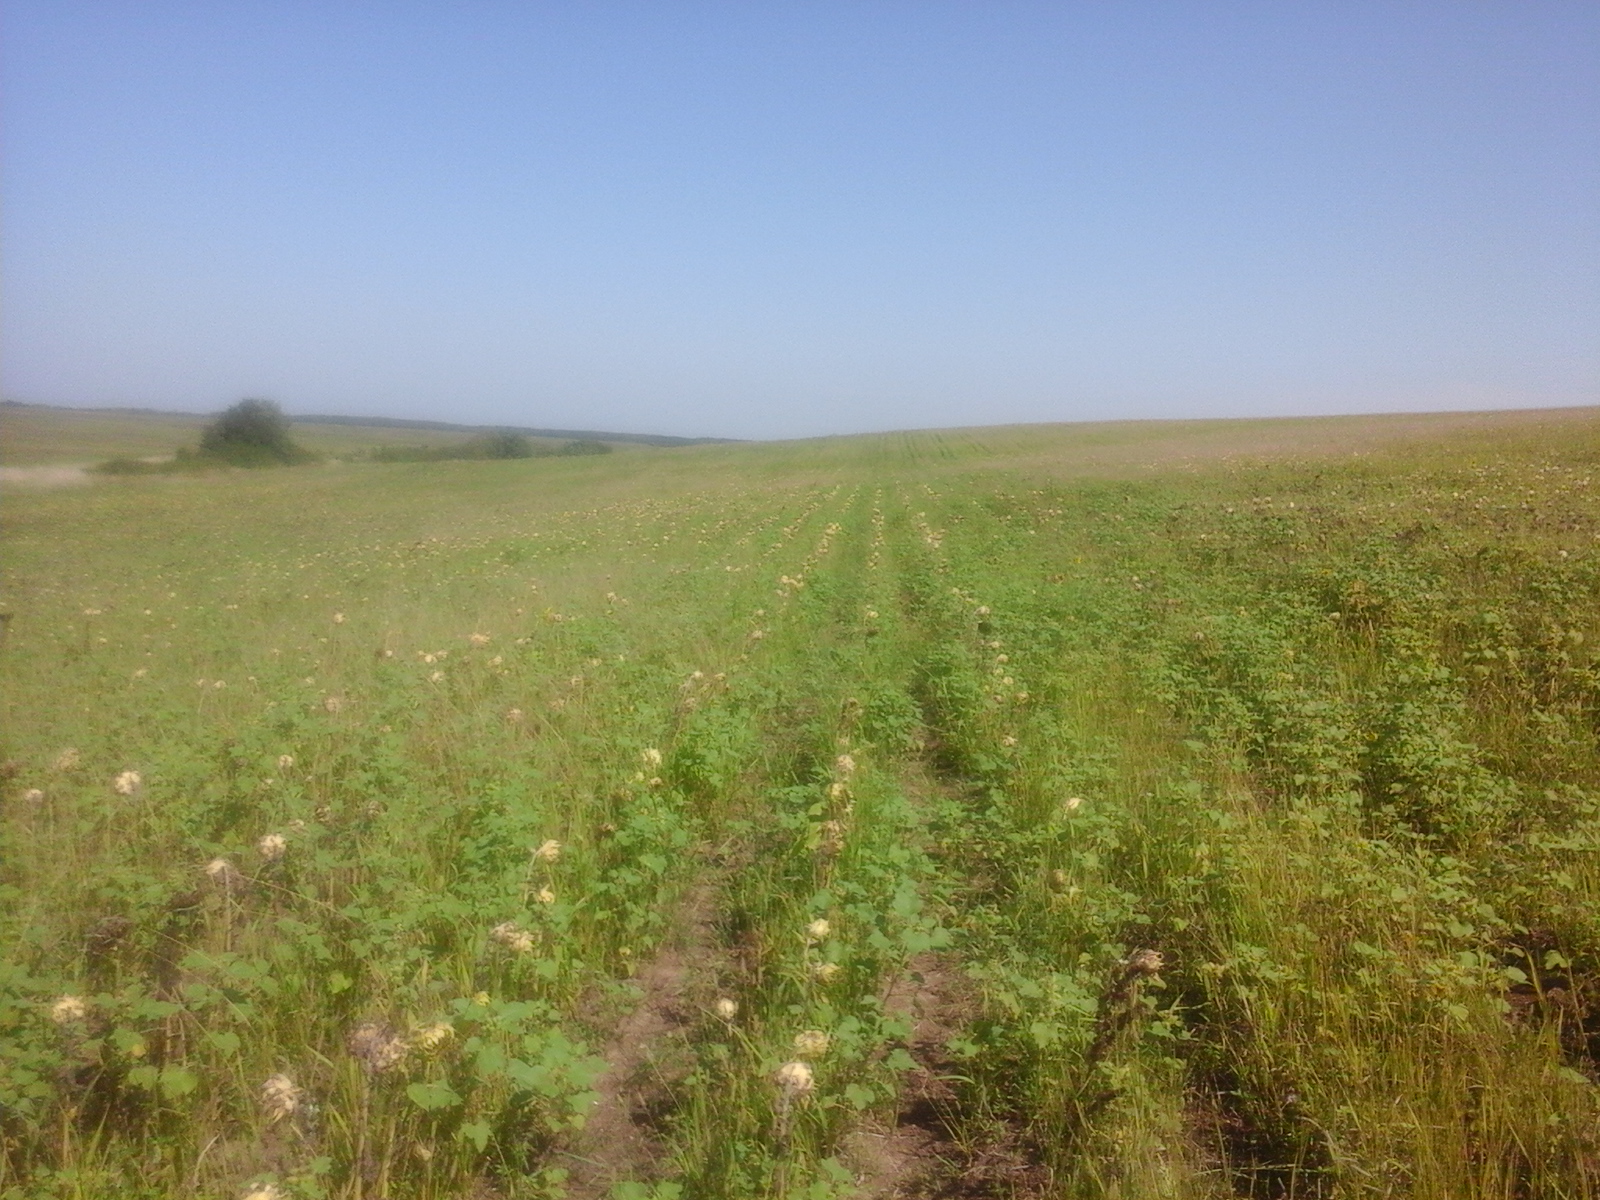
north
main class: Cropland
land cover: Sunflower
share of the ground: 50 - 75 %
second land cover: Spontaneously vegetated surfaces
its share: > 75 %
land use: Agriculture (excluding fallow land and kitchen gardens)
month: August
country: RO
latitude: 45.6315
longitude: 21.7216
